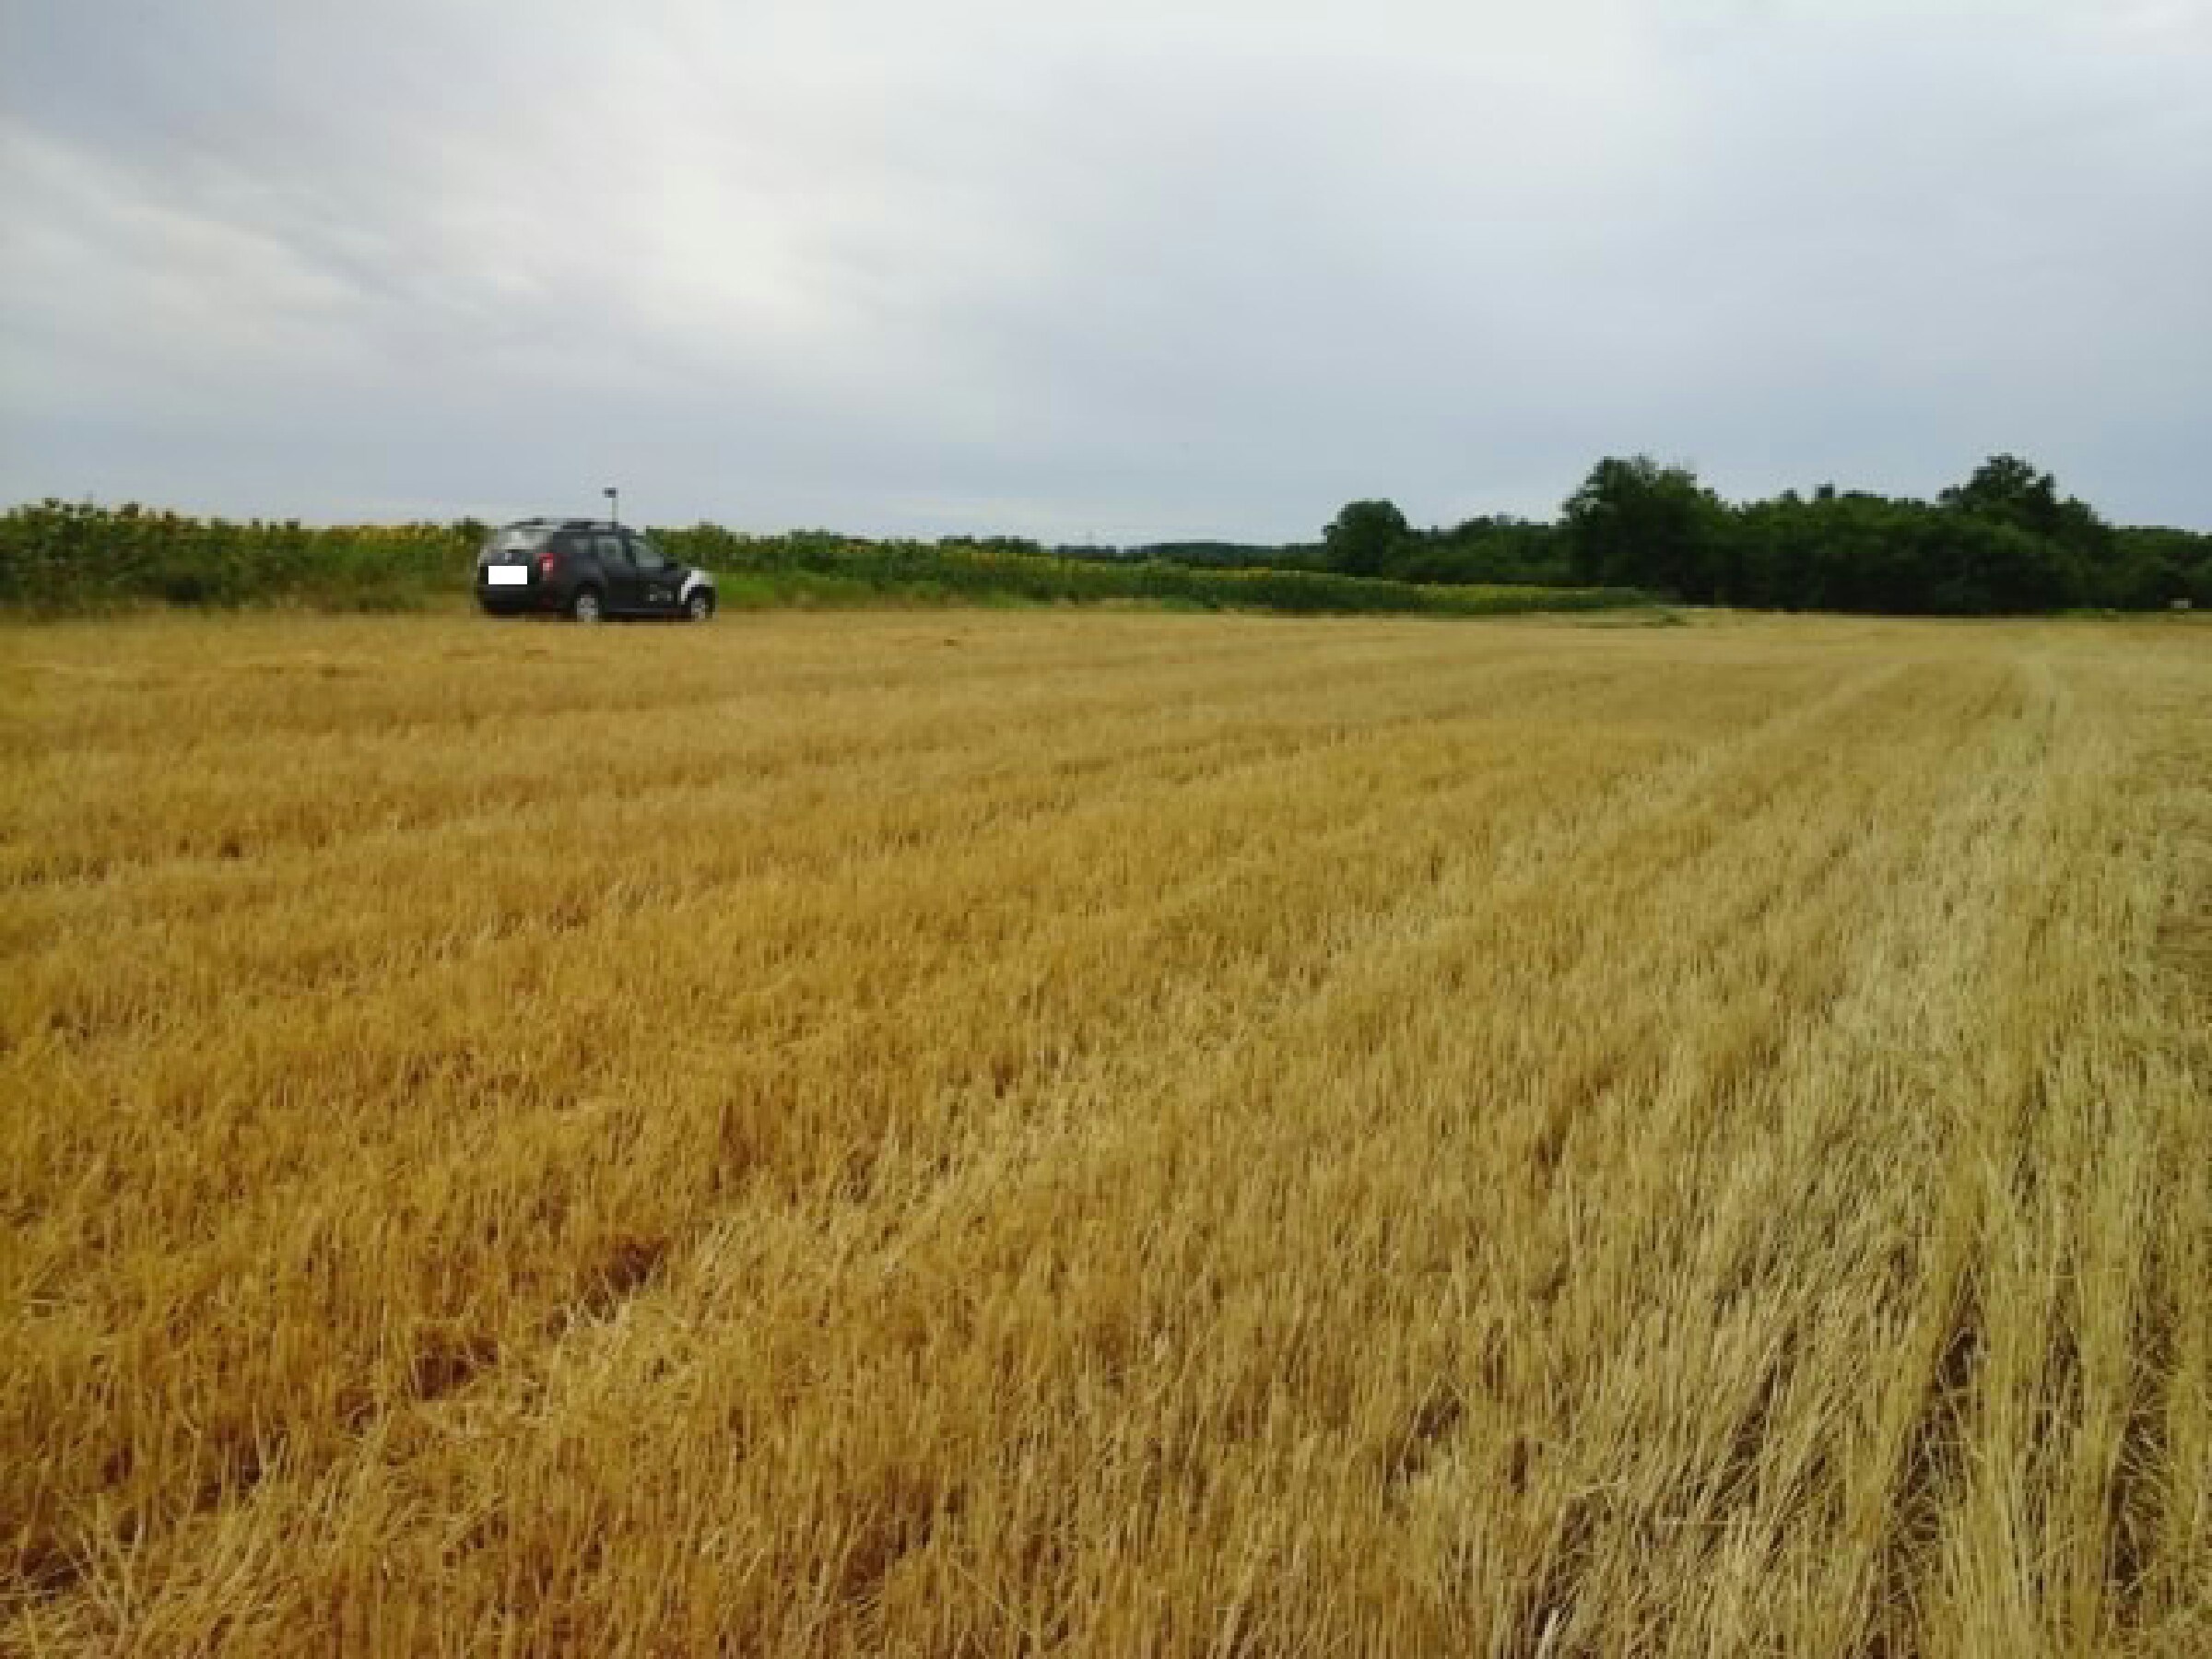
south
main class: Cropland
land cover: Common wheat
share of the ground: > 75 %
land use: Agriculture (excluding fallow land and kitchen gardens)
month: July
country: HU
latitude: 47.7133
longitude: 19.1767
